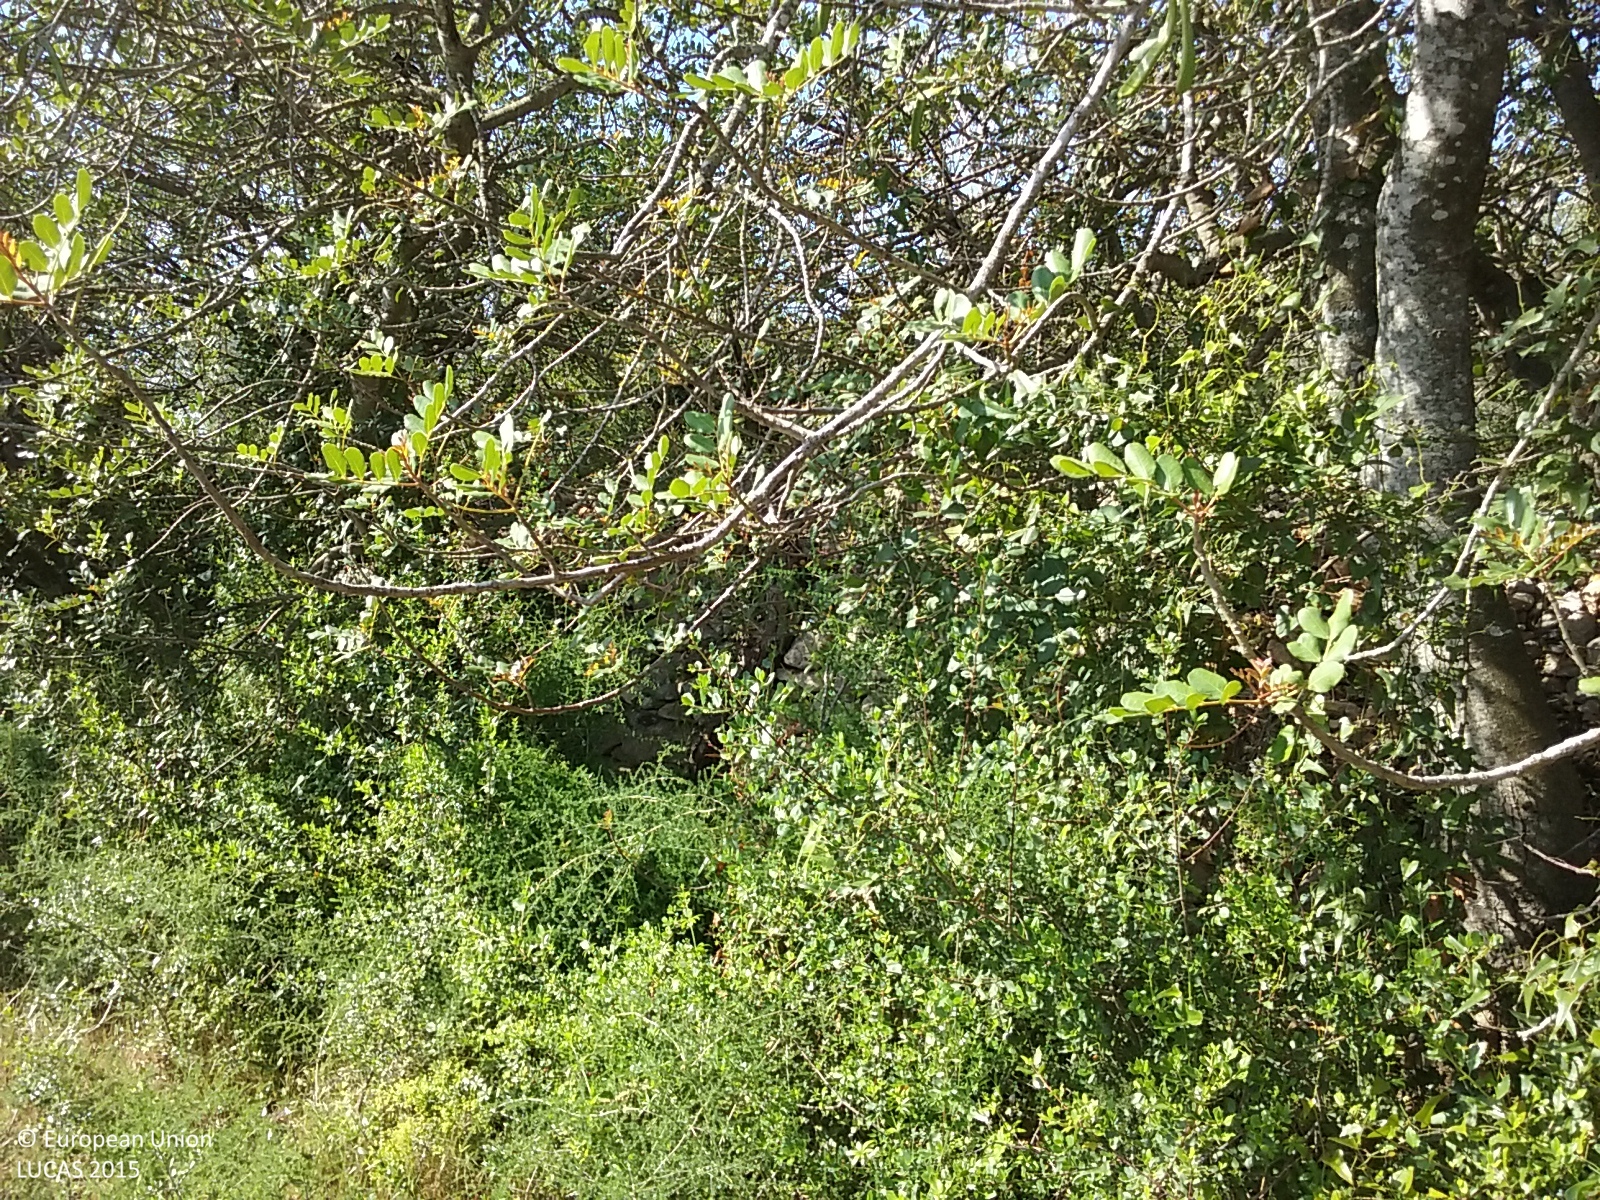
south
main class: Cropland
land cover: Permanent industrial crops
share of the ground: 25 - 50 %
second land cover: Spontaneously vegetated surfaces
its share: 25 - 50 %
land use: Agriculture (excluding fallow land and kitchen gardens)
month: May
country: ES
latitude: 40.5347
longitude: 0.3265
